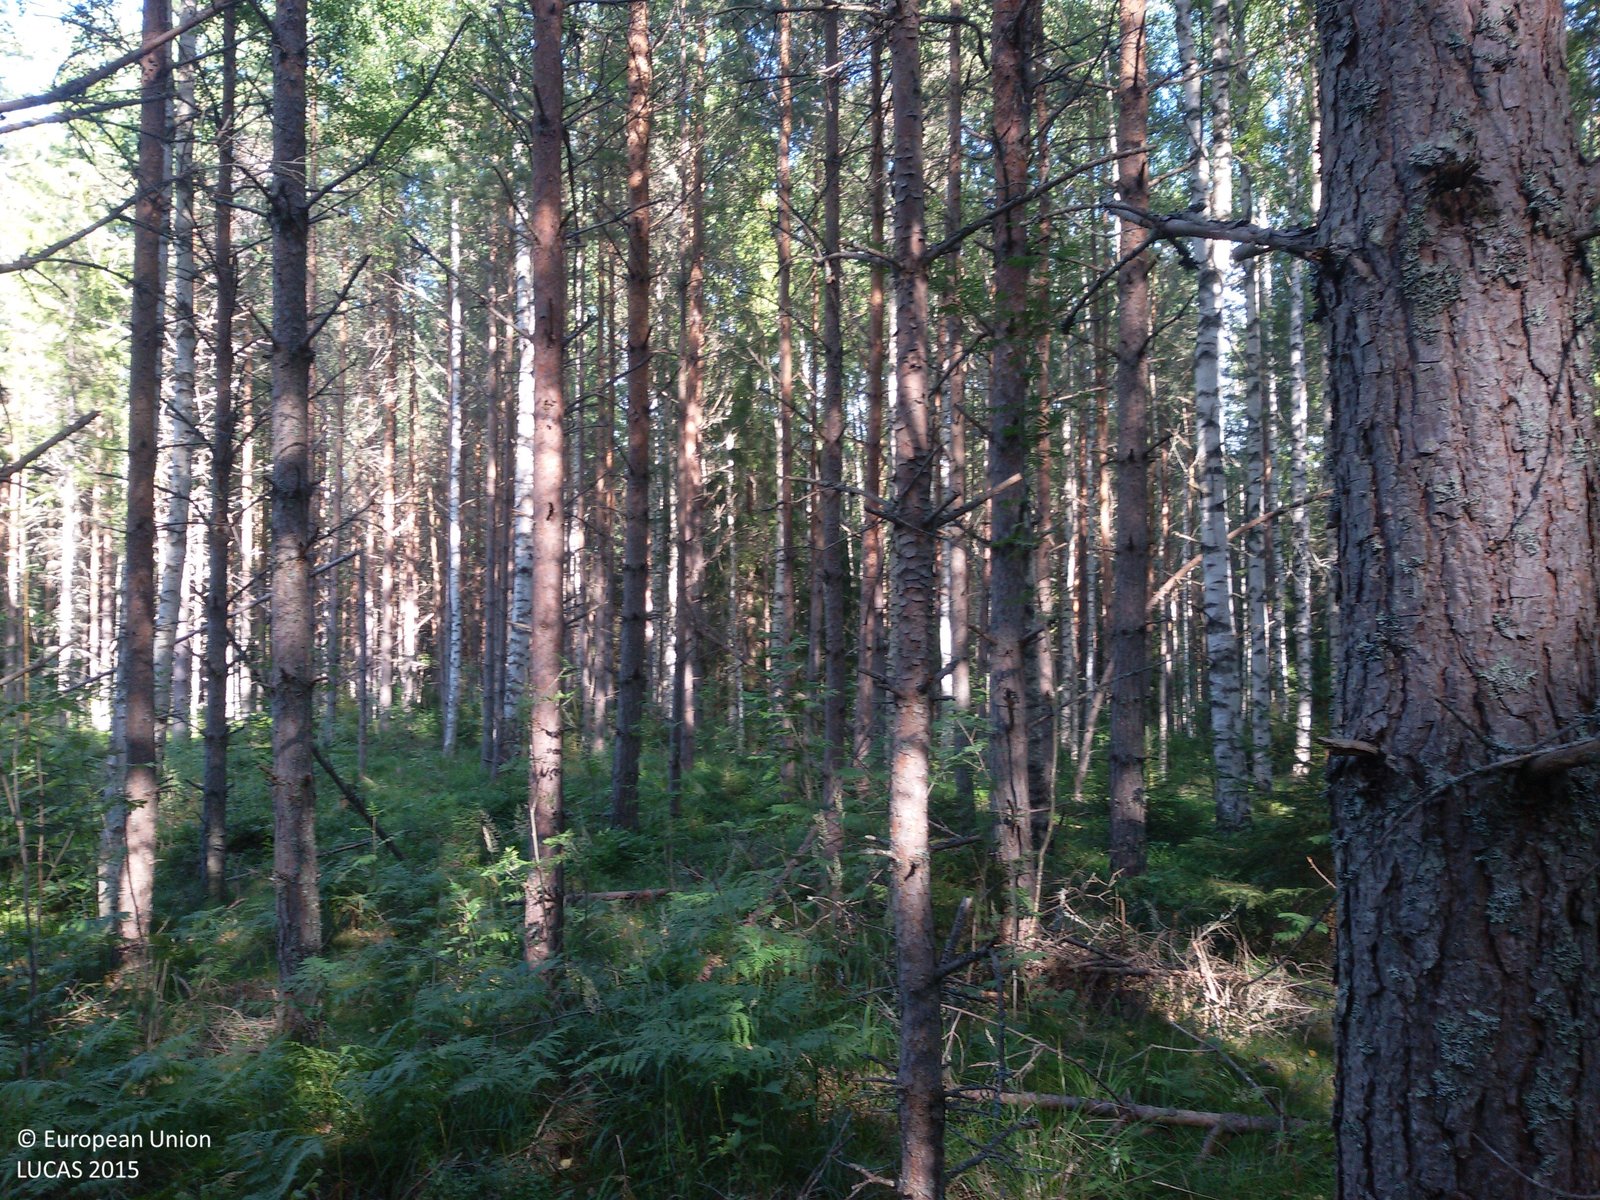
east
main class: Woodland
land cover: Pine dominated mixed woodland
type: boreal forest
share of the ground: > 75 %
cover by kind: coniferous forest trees 50 %, broadleaved forest trees 45 %, shrubs 5 %
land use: Forestry
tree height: > 5 m
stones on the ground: < 10 %
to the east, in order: Pine dominated mixed woodland; Rivers and streams; Pine dominated coniferous woodland; Pine dominated mixed woodland; Pine dominated coniferous woodland; Pine dominated mixed woodland
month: August
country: SE
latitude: 60.5762
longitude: 16.4298
